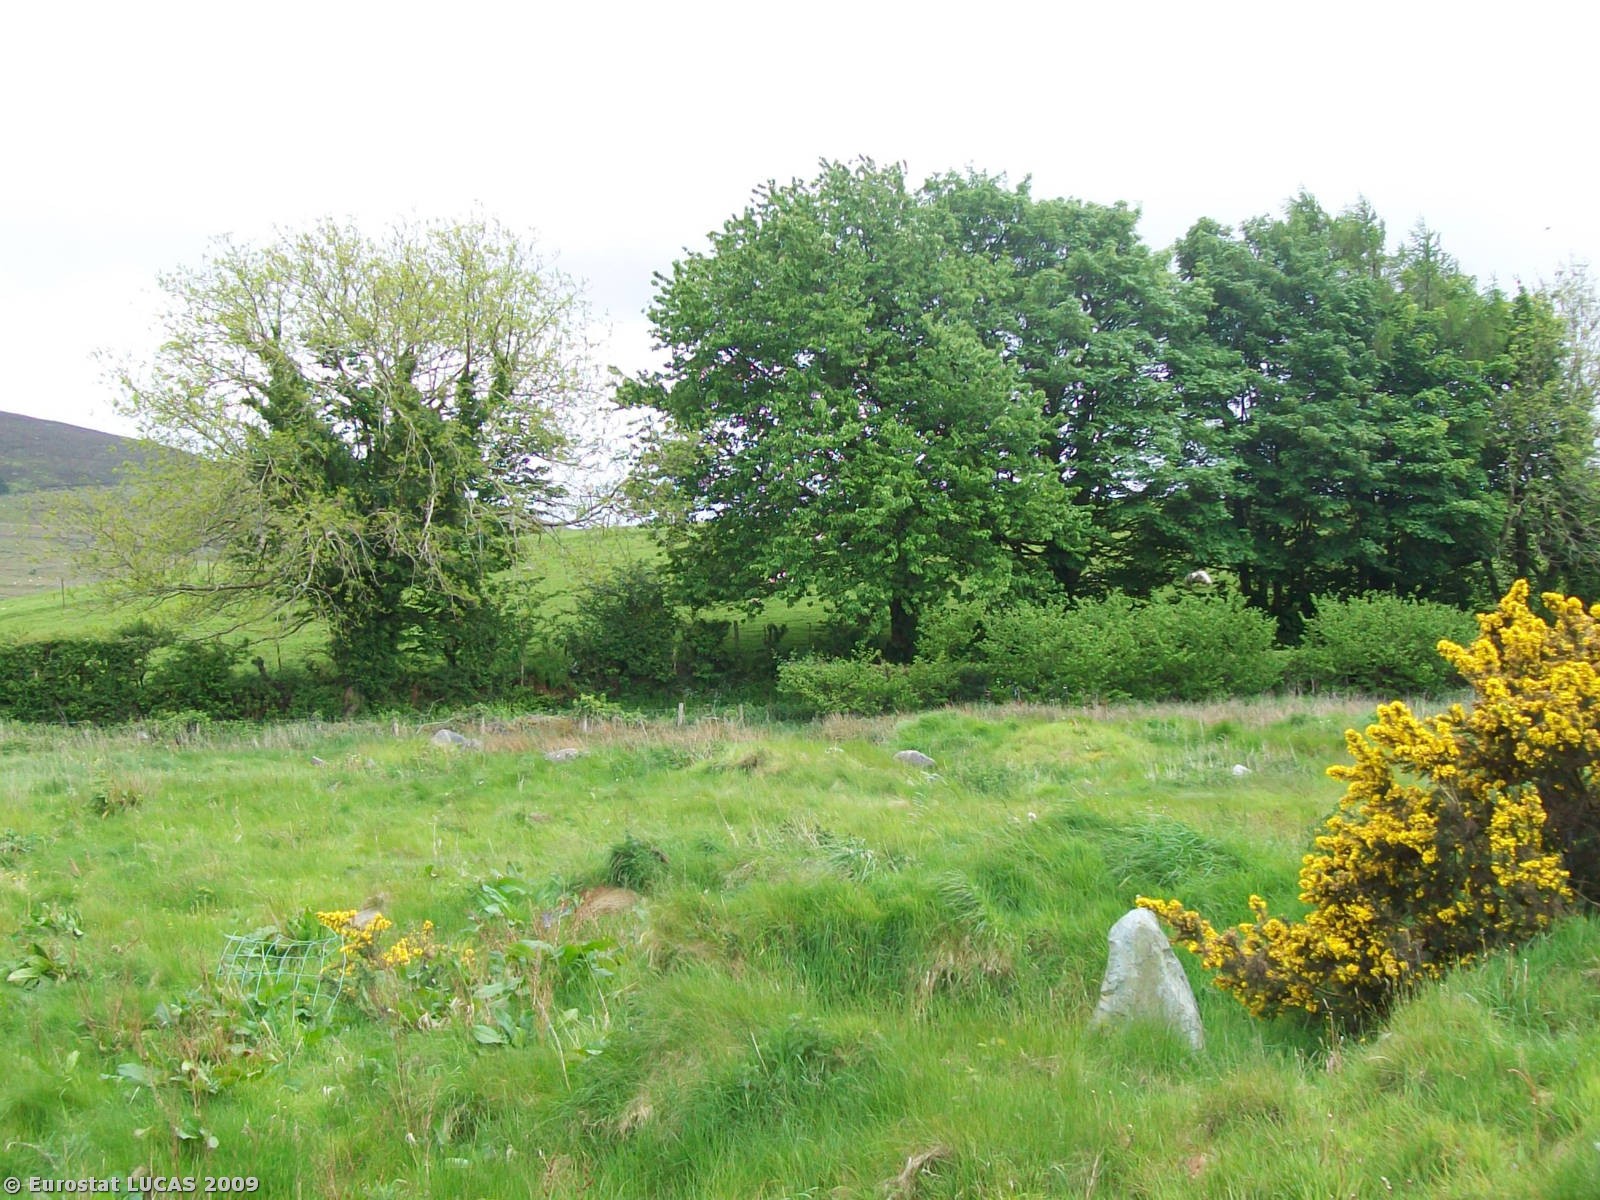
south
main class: Shrubland
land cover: Shrubland without tree cover
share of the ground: > 75 %
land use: Agriculture (excluding fallow land and kitchen gardens)
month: May
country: GB
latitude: 53.1689
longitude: -4.1438
